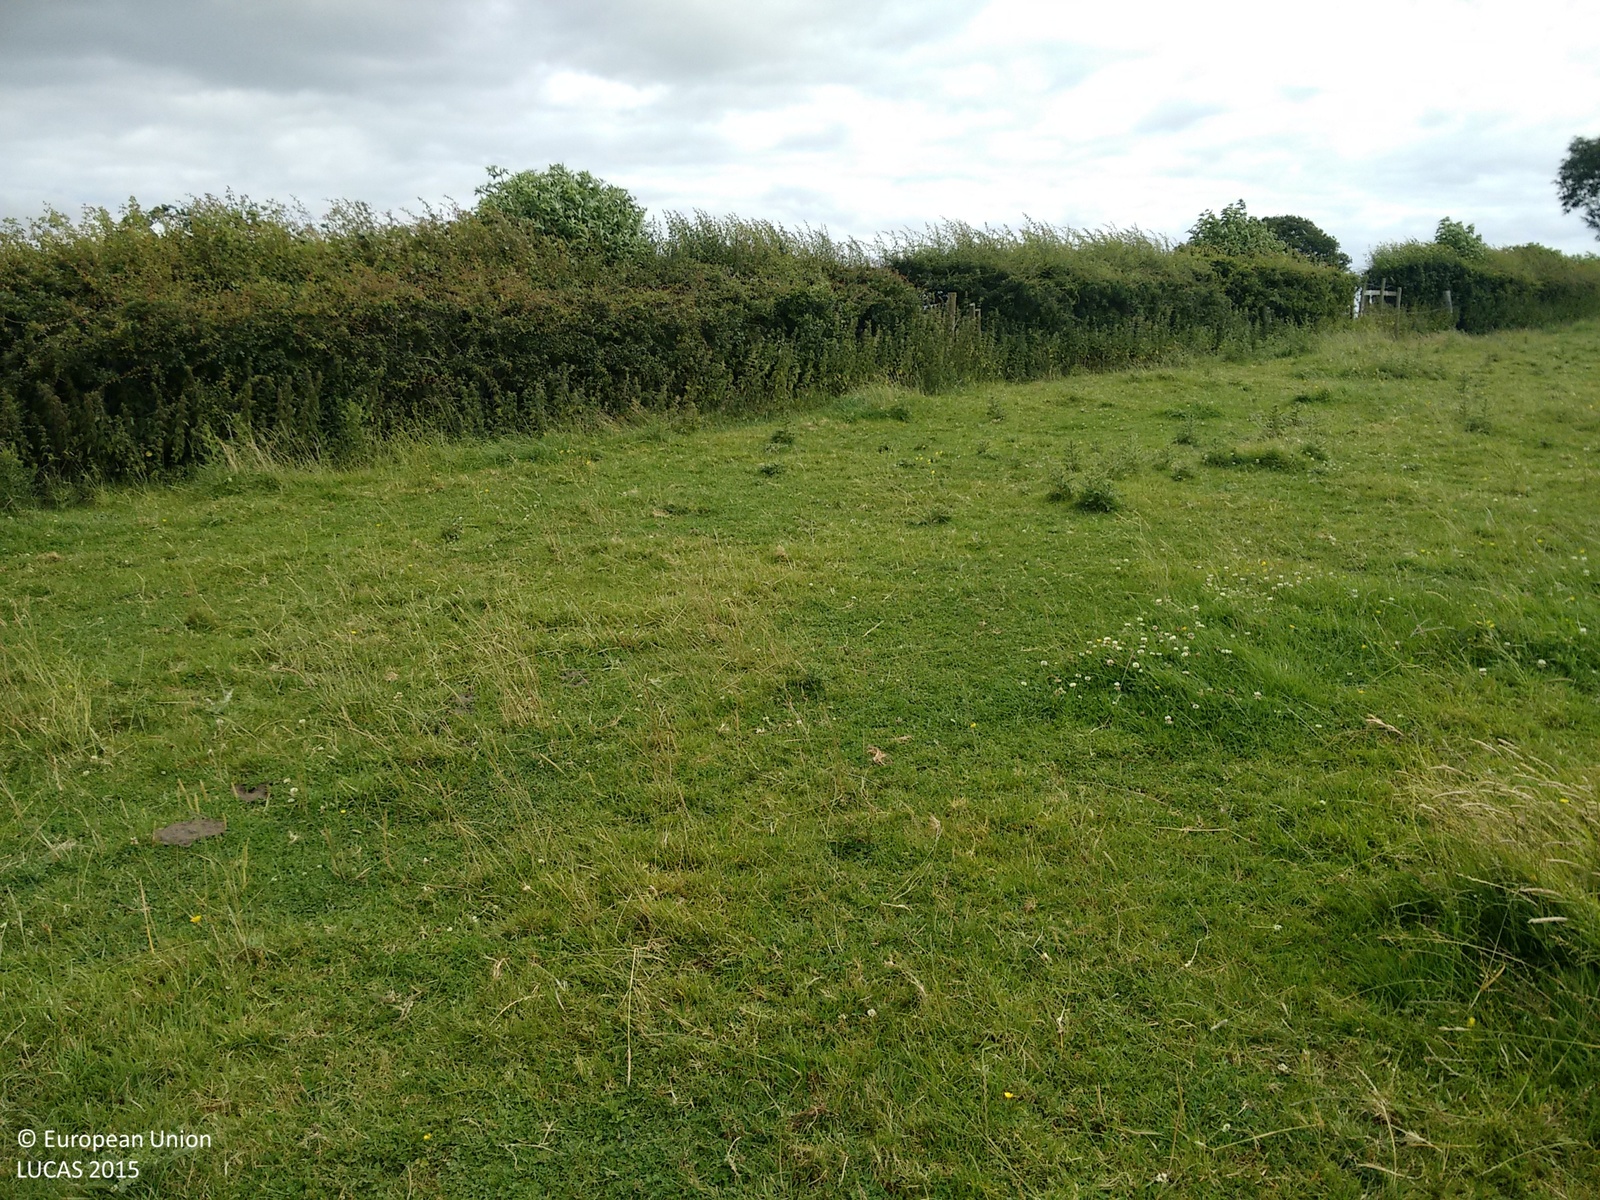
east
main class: Grassland
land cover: Grassland without tree/shrub cover
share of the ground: > 75 %
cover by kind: herbaceous plants 100 %
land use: Agriculture (excluding fallow land and kitchen gardens)
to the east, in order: Grassland without tree/shrub cover; Fences; Managed hedges; Fences; Grassland without tree/shrub cover; Fences; Managed hedges; Fences; Grassland without tree/shrub cover; Fences; Managed hedges; Fences; Grassland without tree/shrub cover
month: July
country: GB
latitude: 53.0176
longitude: -1.6652
